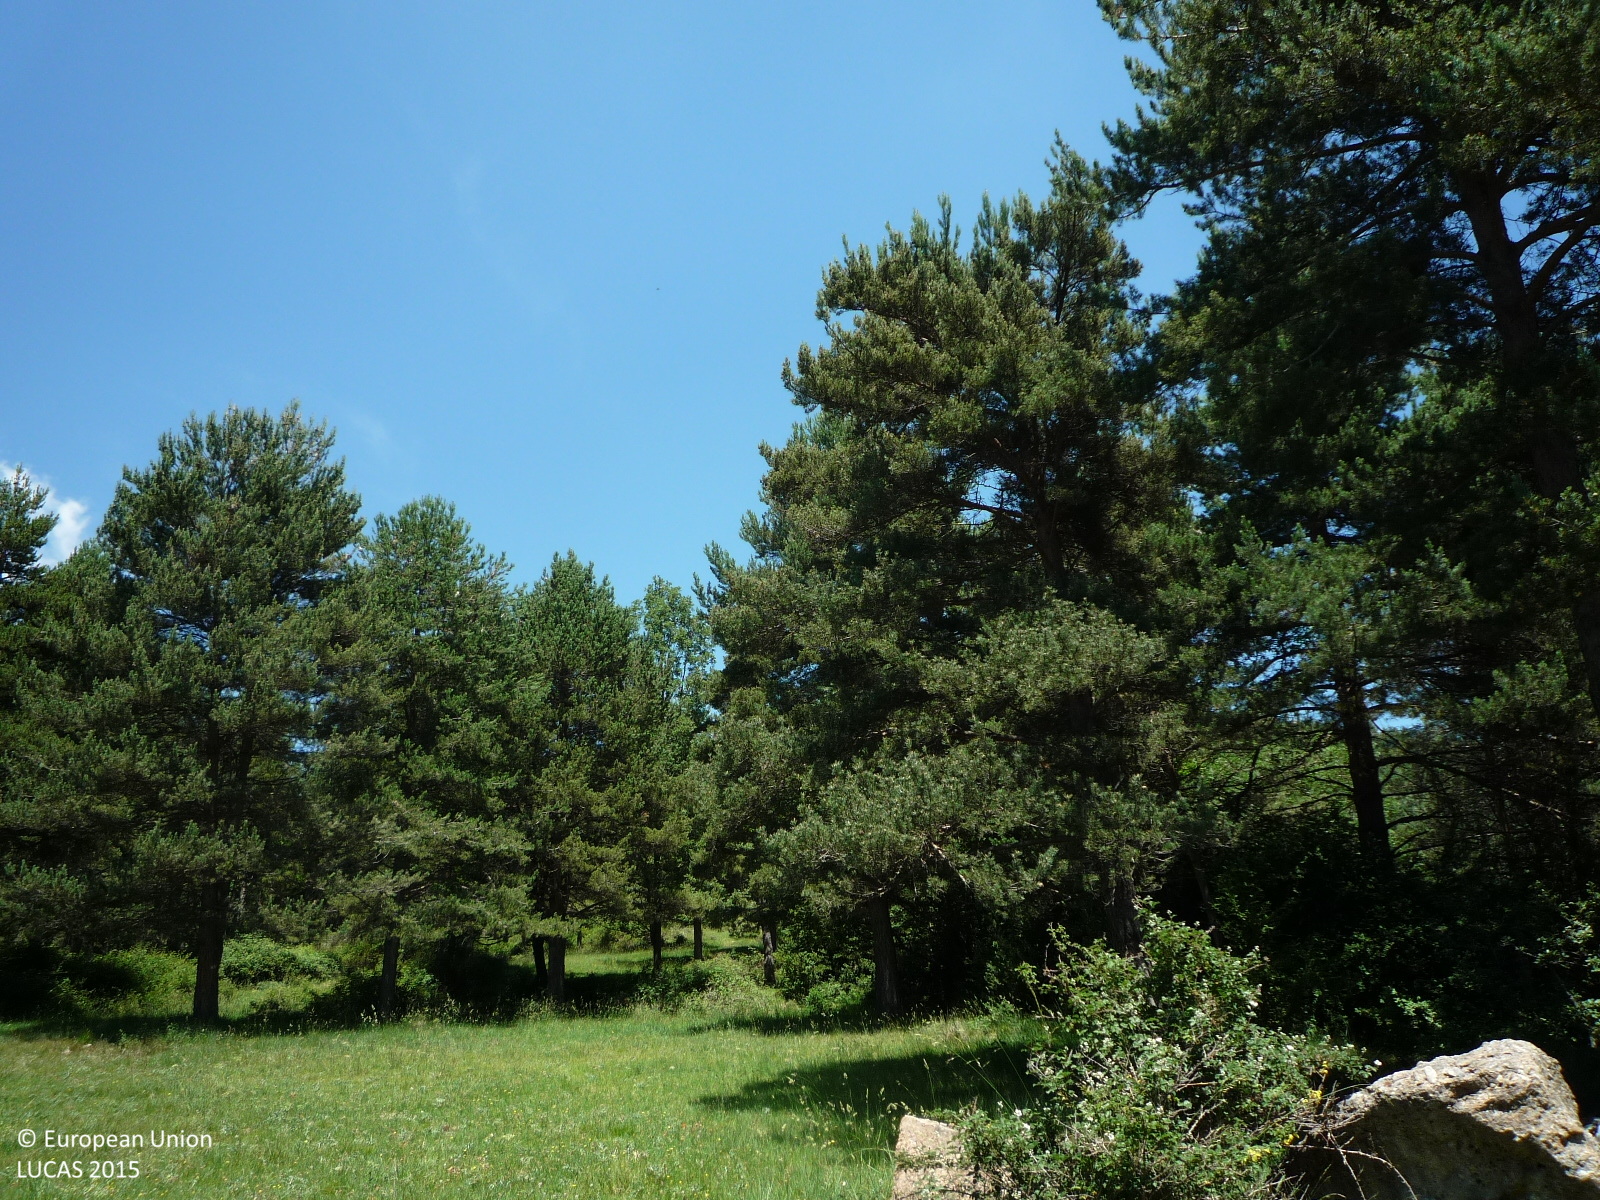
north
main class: Grassland
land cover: Grassland without tree/shrub cover
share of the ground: > 75 %
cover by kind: herbaceous plants 100 %
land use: Agriculture (excluding fallow land and kitchen gardens)
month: June
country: ES
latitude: 42.1908
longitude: 1.9844
